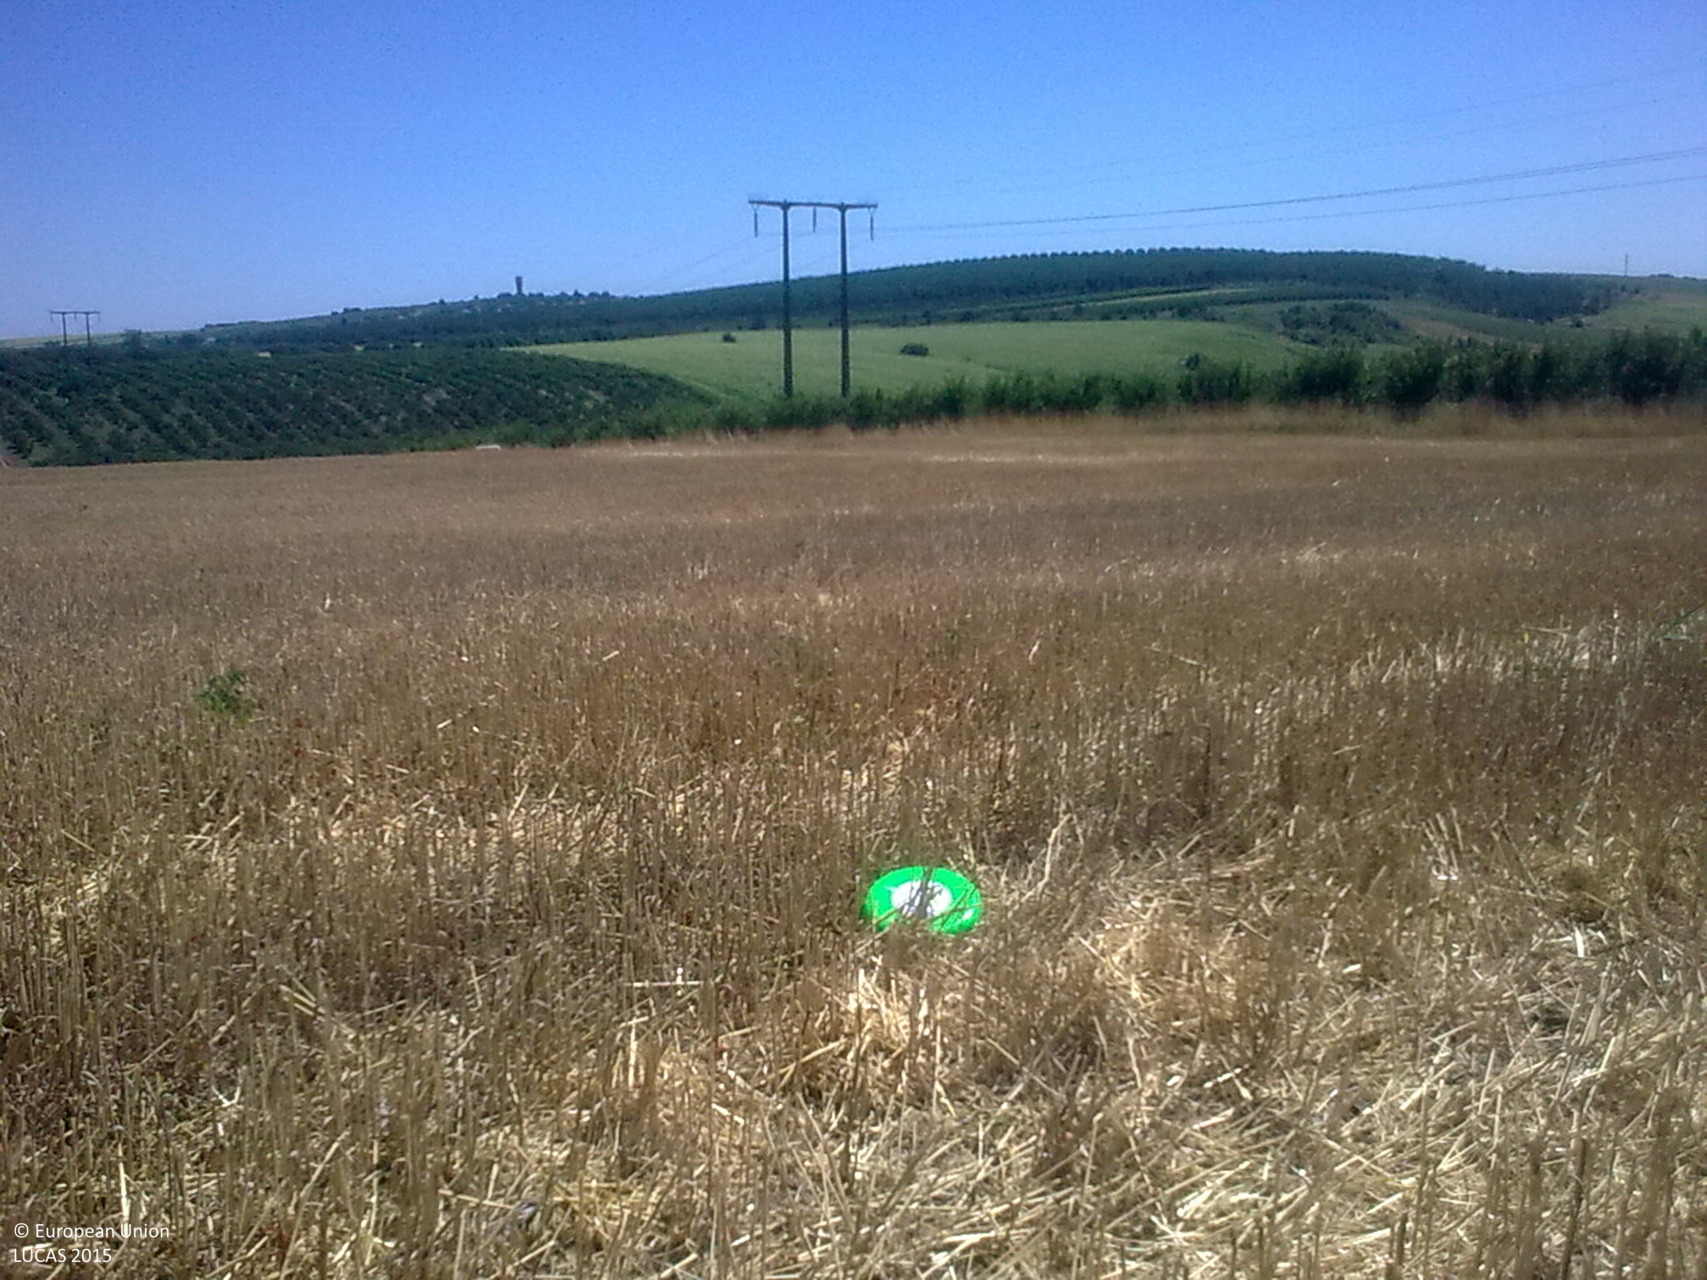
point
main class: Cropland
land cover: Common wheat
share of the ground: 50 - 75 %
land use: Agriculture (excluding fallow land and kitchen gardens)
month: July
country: BG
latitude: 43.9001
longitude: 26.2762
